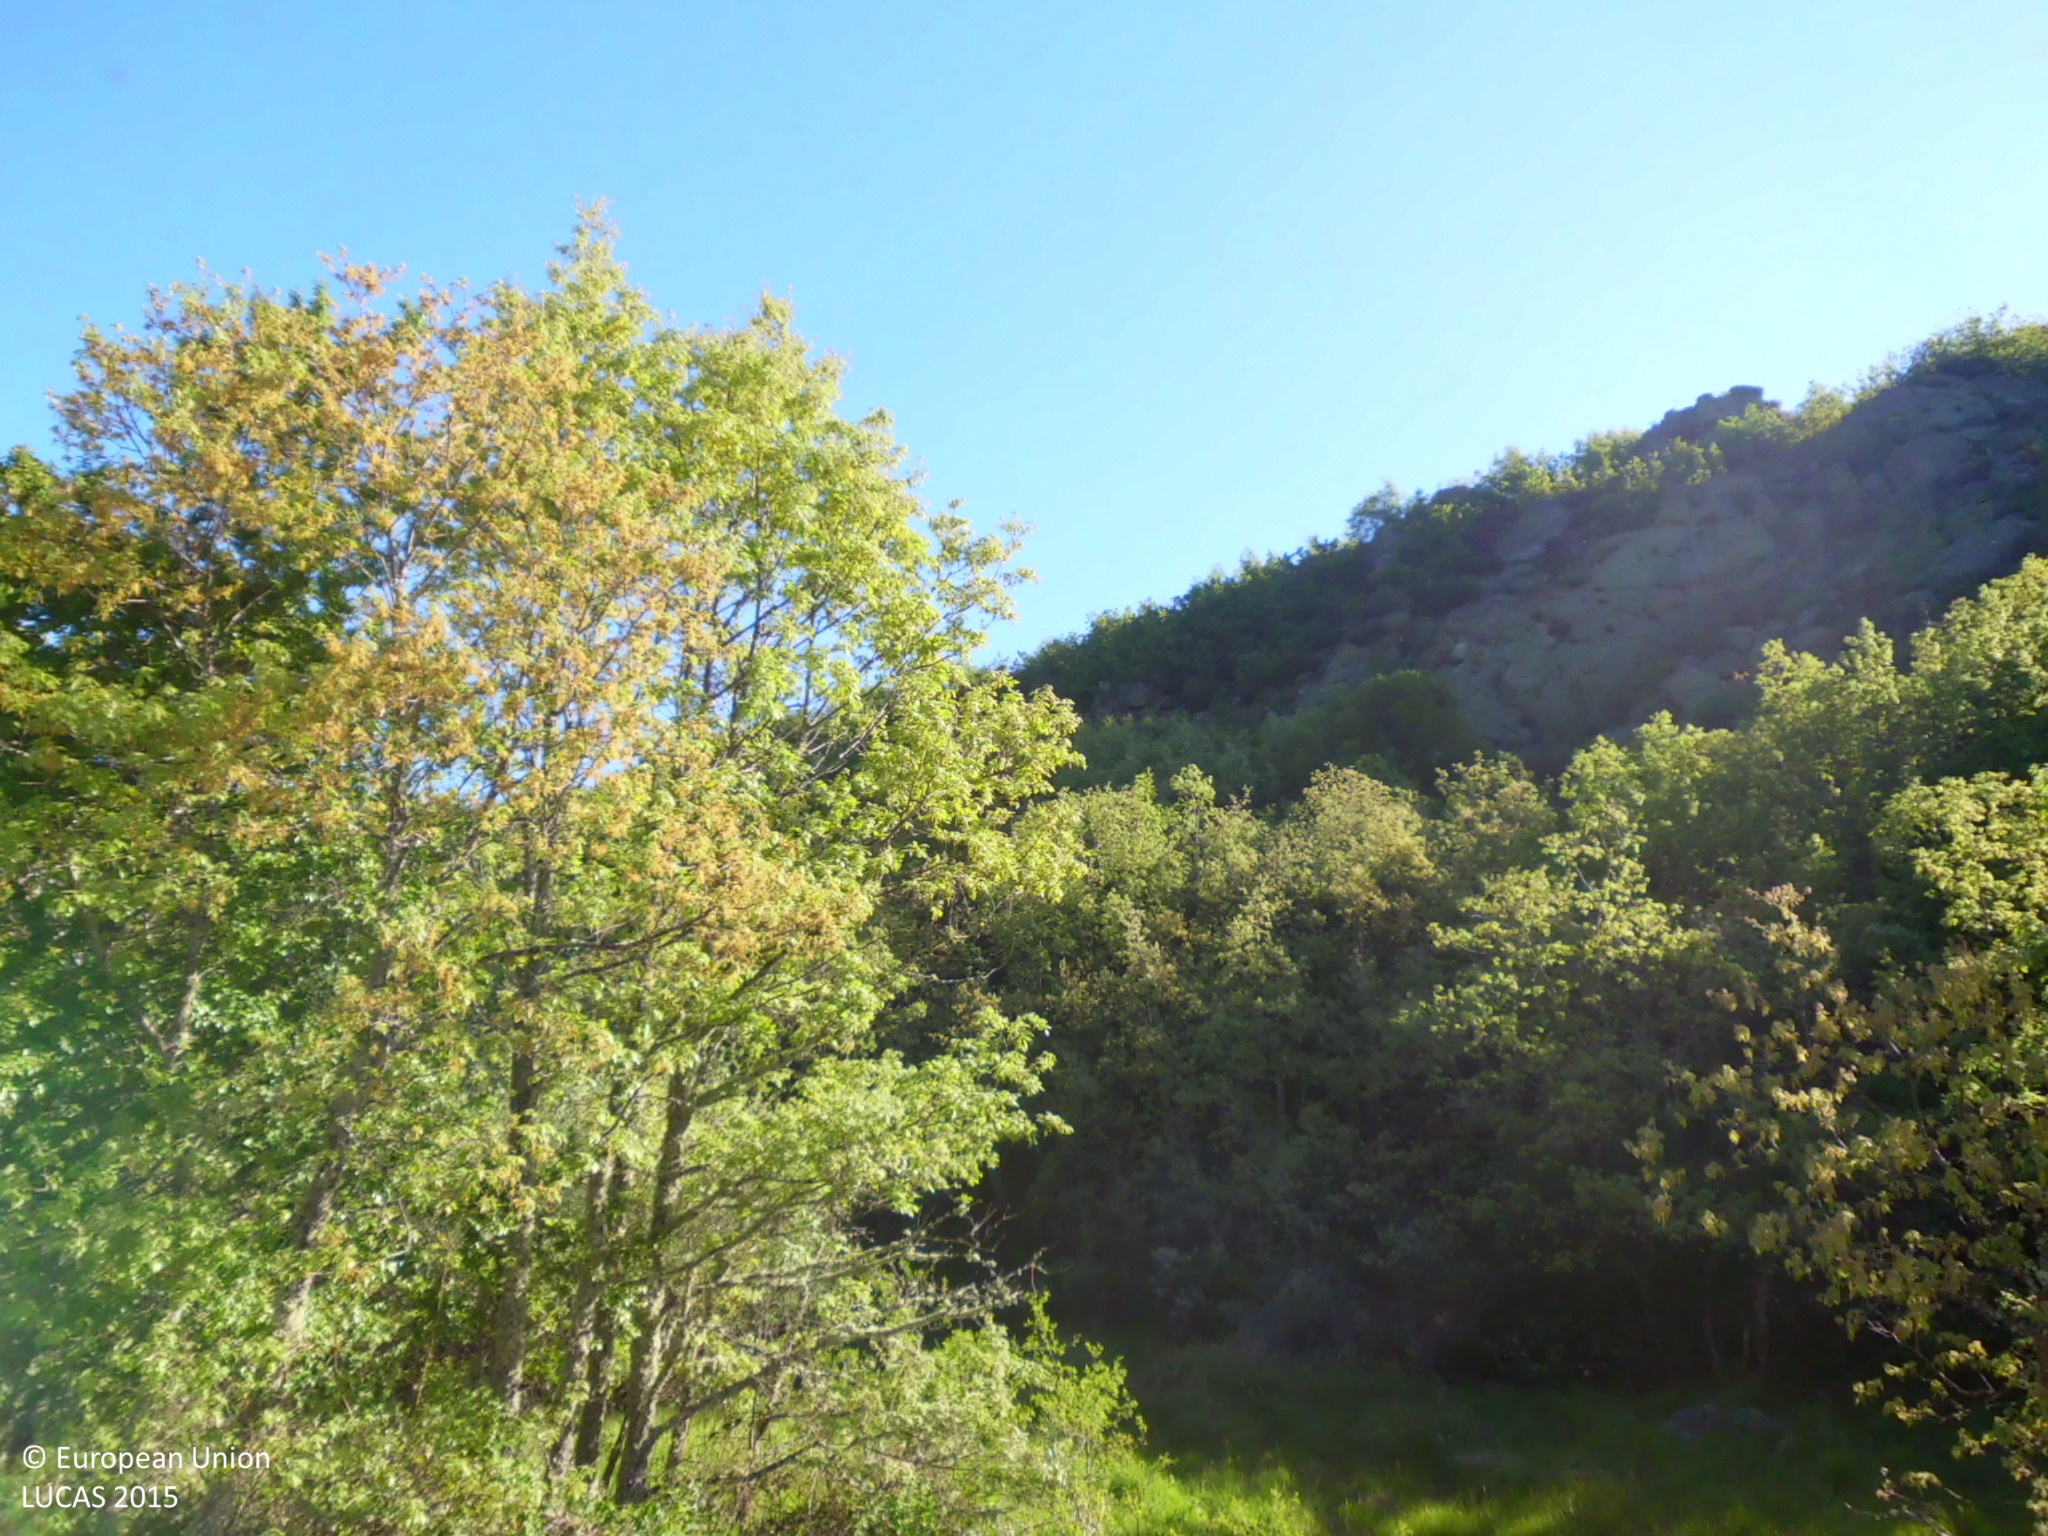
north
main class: Grassland
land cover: Grassland without tree/shrub cover
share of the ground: 50 - 75 %
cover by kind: herbaceous plants 55 %, consolidated bare surface 40 %, shrubs 5 %
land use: Semi-natural and natural areas not in use
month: May
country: ES
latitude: 42.9018
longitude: -4.5198
